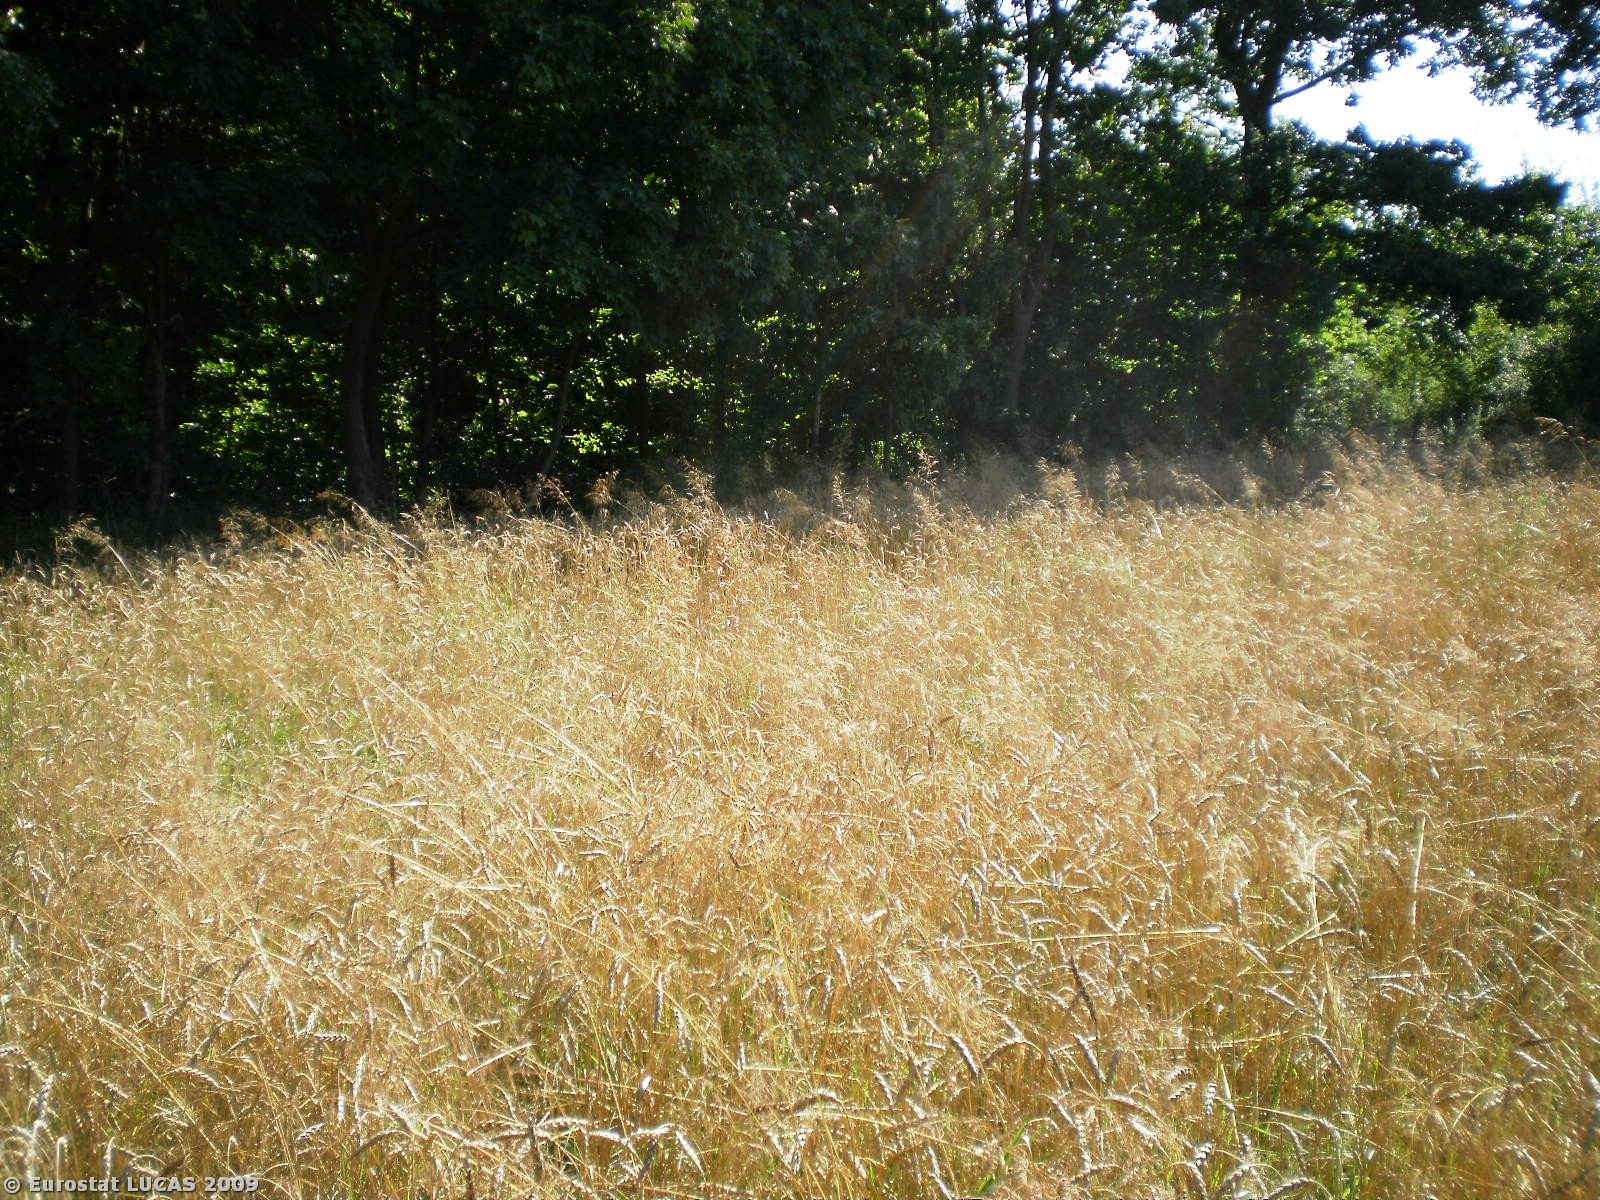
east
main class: Cropland
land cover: Common wheat
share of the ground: > 75 %
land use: Agriculture (excluding fallow land and kitchen gardens)
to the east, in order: Common wheat; Broadleaved woodland; Fences; Grass margins; Tracks; Grass margins; Broadleaved woodland; Fences; Grassland without tree/shrub cover; Fences; Broadleaved woodland
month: August
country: PL
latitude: 53.8094
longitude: 20.5617
